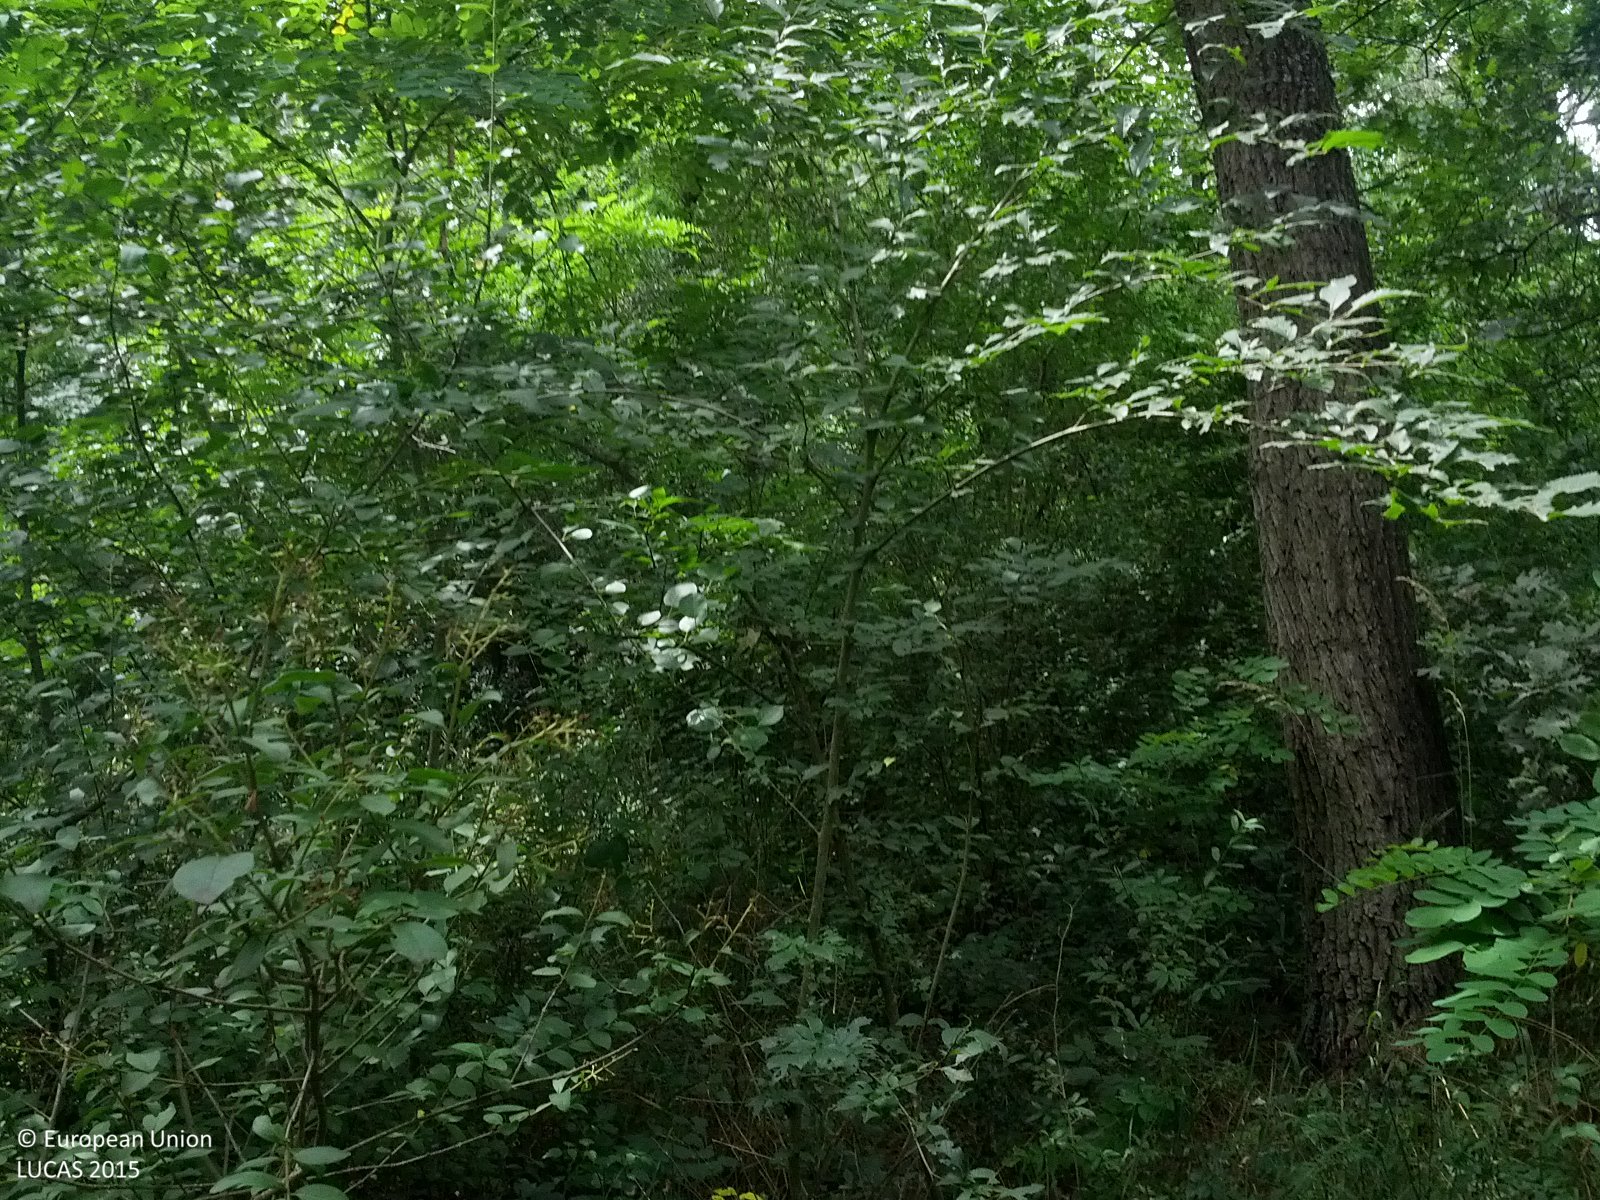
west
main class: Woodland
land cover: Broadleaved woodland
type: acidophilous oak and oak-birch forest
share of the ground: 50 - 75 %
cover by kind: broadleaved forest trees 65 %, shrubs 20 %, herbaceous plants 15 %
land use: Forestry
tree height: > 5 m
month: June
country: AT
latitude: 48.3309
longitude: 16.6293
